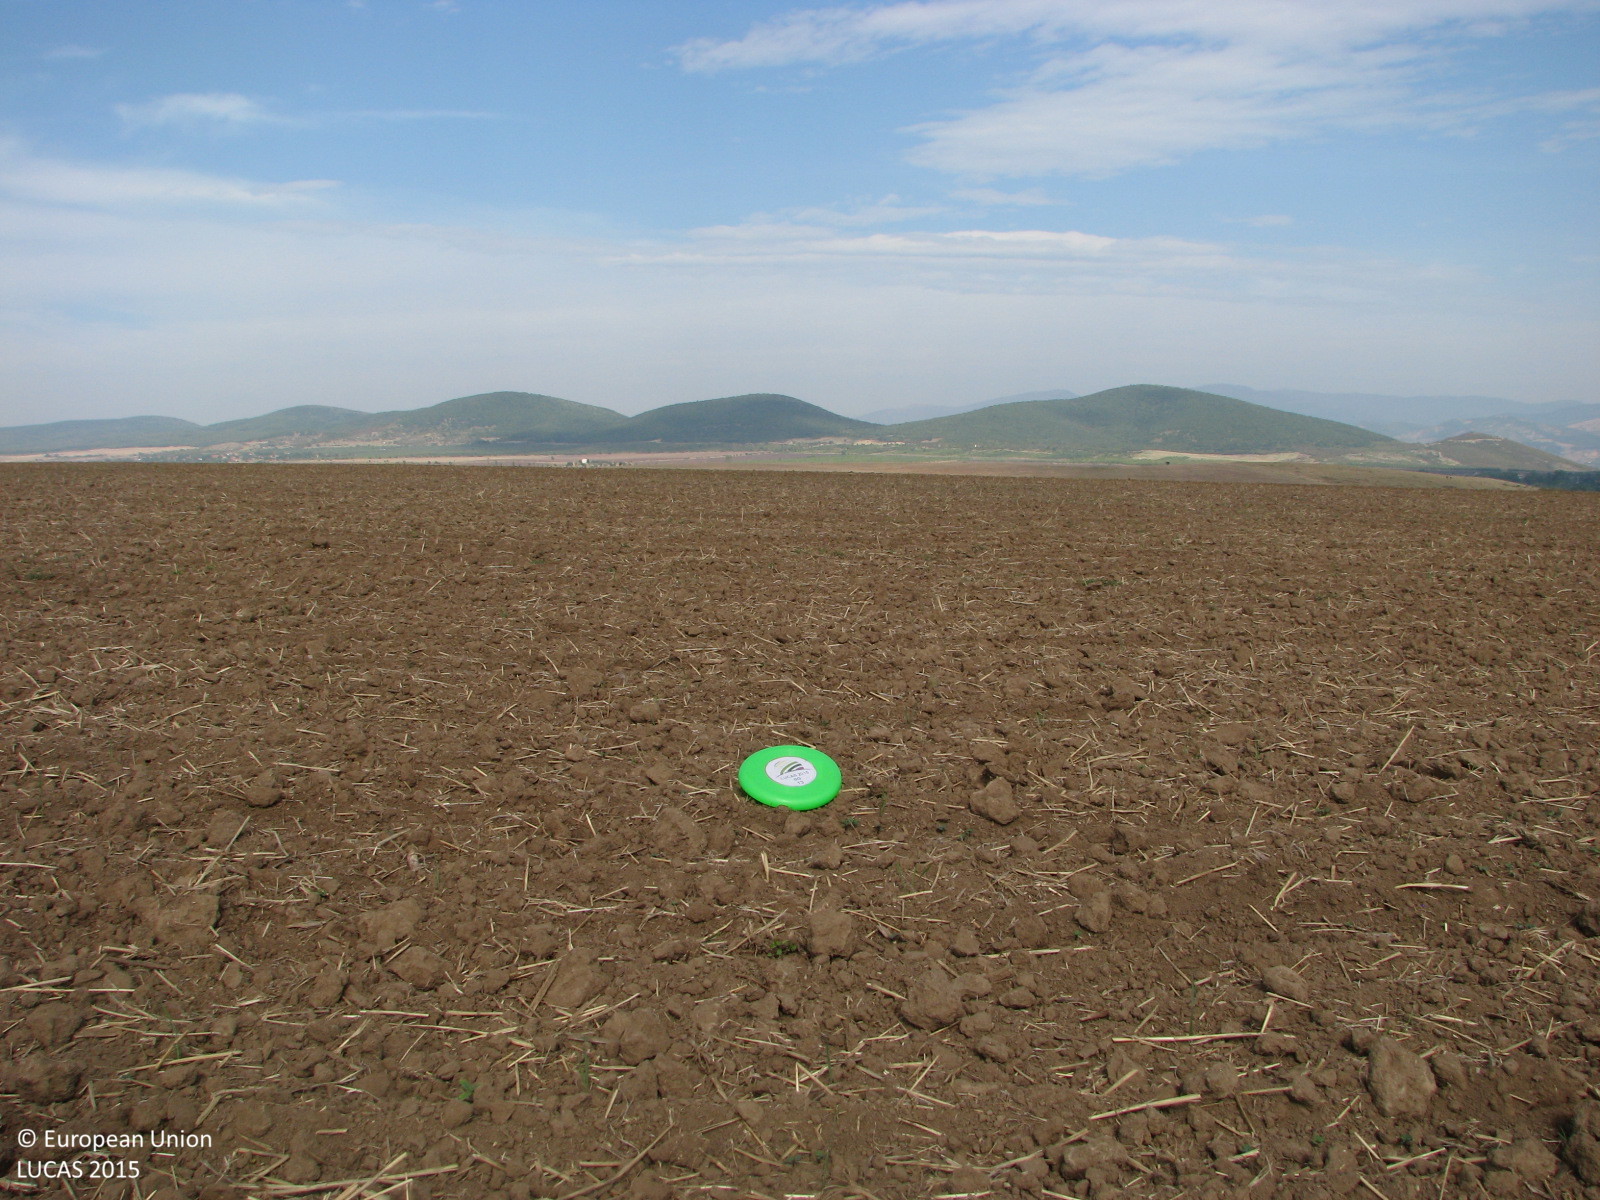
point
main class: Cropland
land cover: Common wheat
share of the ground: < 10 %
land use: Agriculture (excluding fallow land and kitchen gardens)
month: September
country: BG
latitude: 42.5707
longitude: 26.2034
